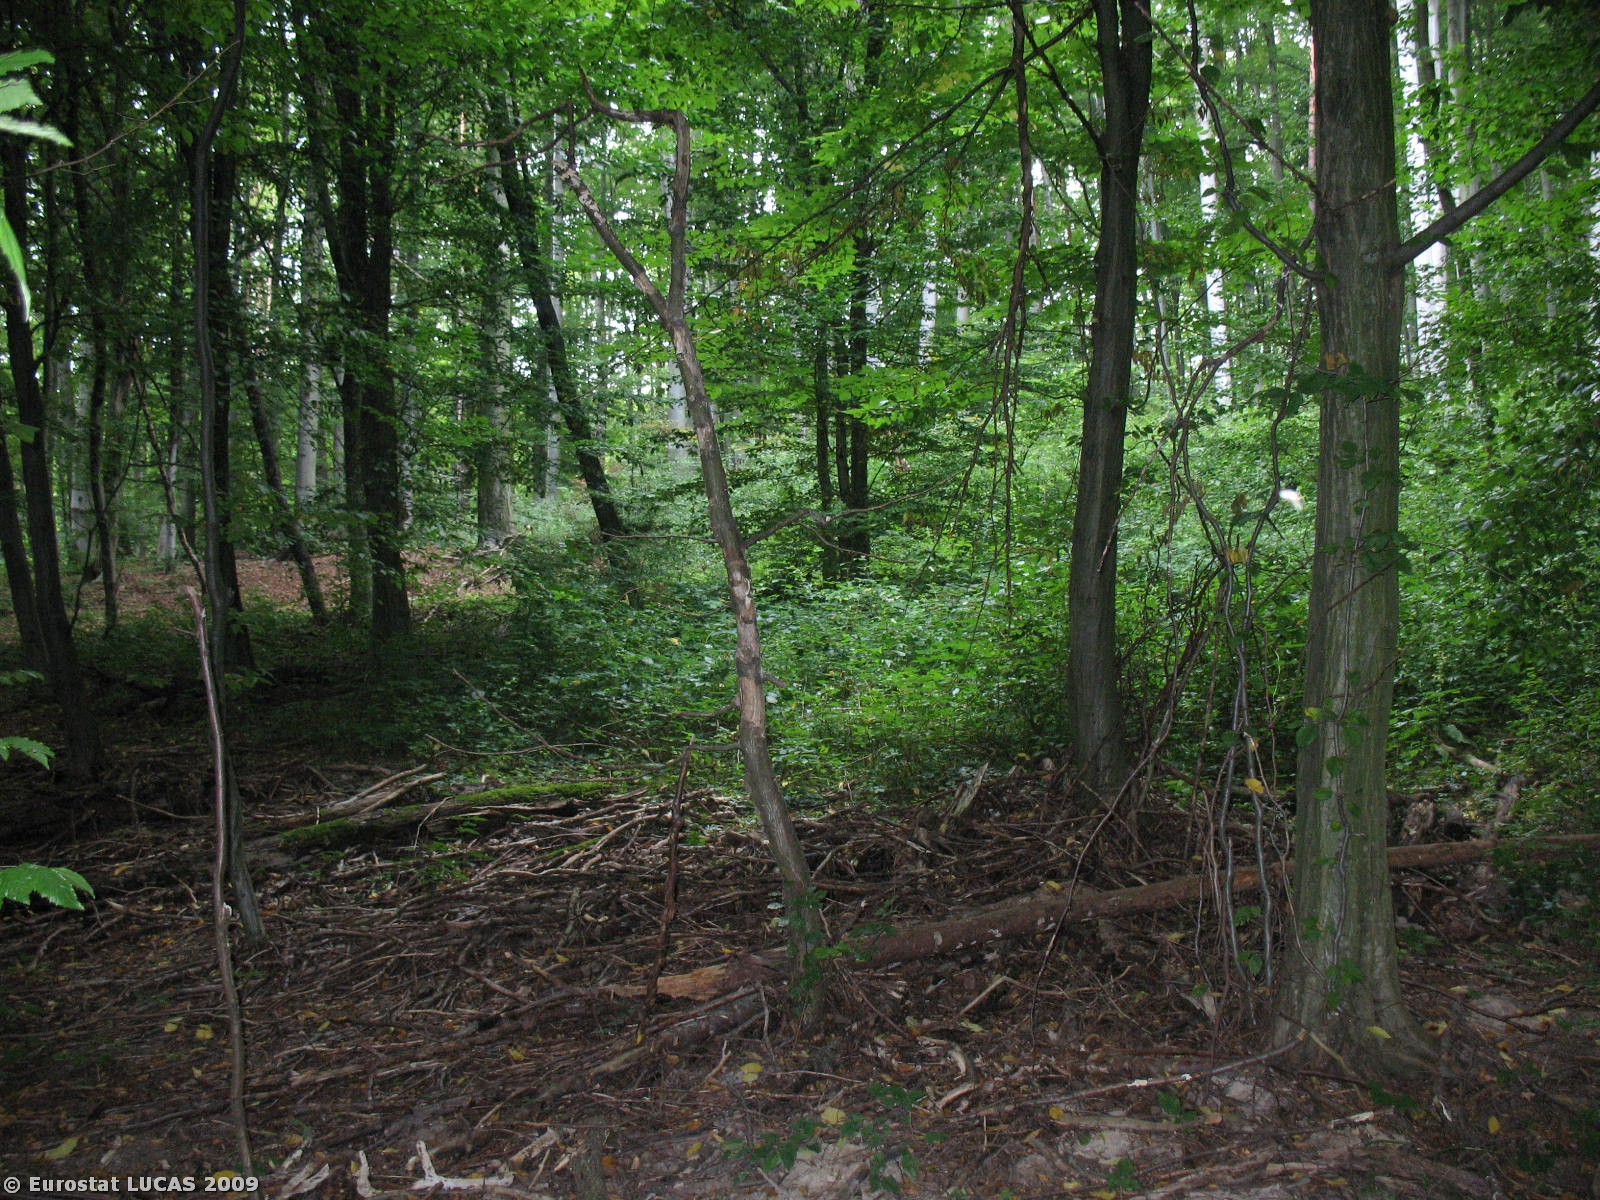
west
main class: Woodland
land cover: Broadleaved woodland
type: mesophytic deciduous forest
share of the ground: > 75 %
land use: Unused
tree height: > 5 m
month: August
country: PL
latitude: 49.7133
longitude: 22.6459
